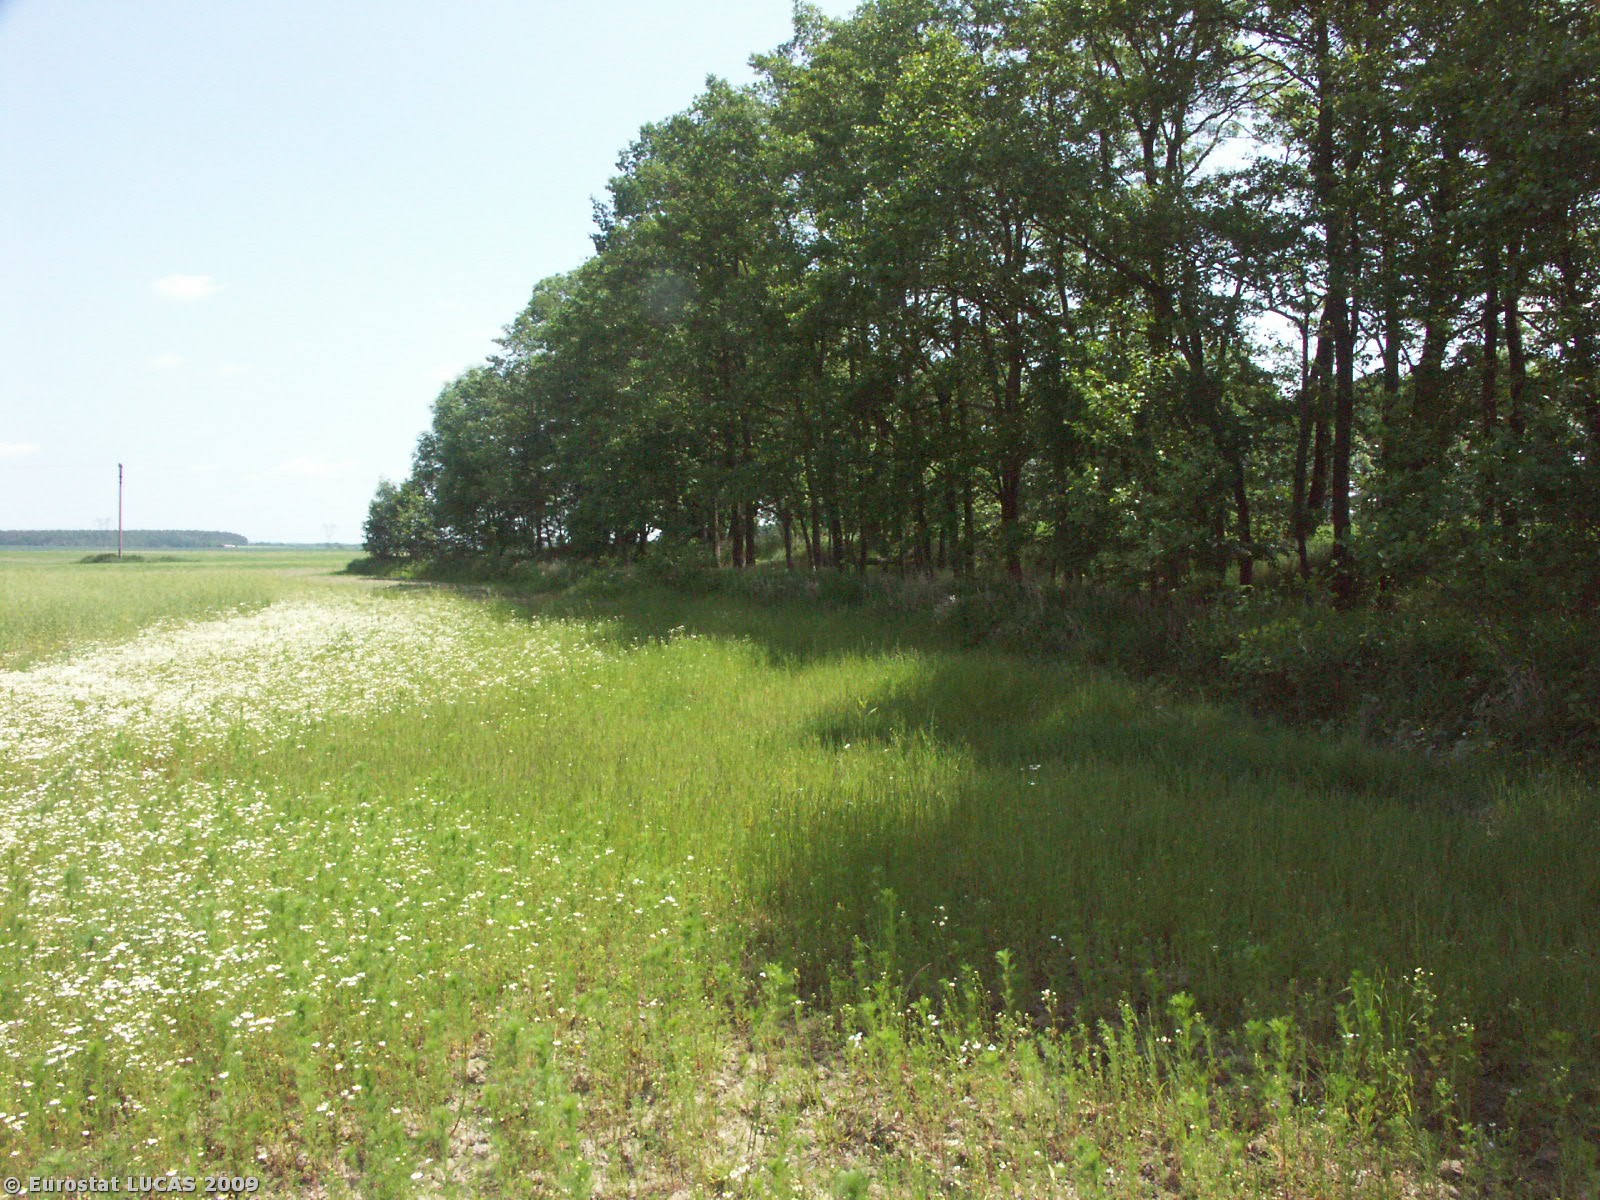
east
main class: Grassland
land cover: Spontaneously vegetated surfaces
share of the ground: > 75 %
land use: Fallow land
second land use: Nature reserves
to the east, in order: Spontaneously vegetated surfaces; Broadleaved woodland; Ditches and canals; Broadleaved woodland; Inland running water; Broadleaved woodland; Inland running water; Broadleaved woodland; Ditches and canals; Grass margins; Maize; Electric lines; Maize
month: May
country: CZ
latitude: 49.0966
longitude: 14.6991
